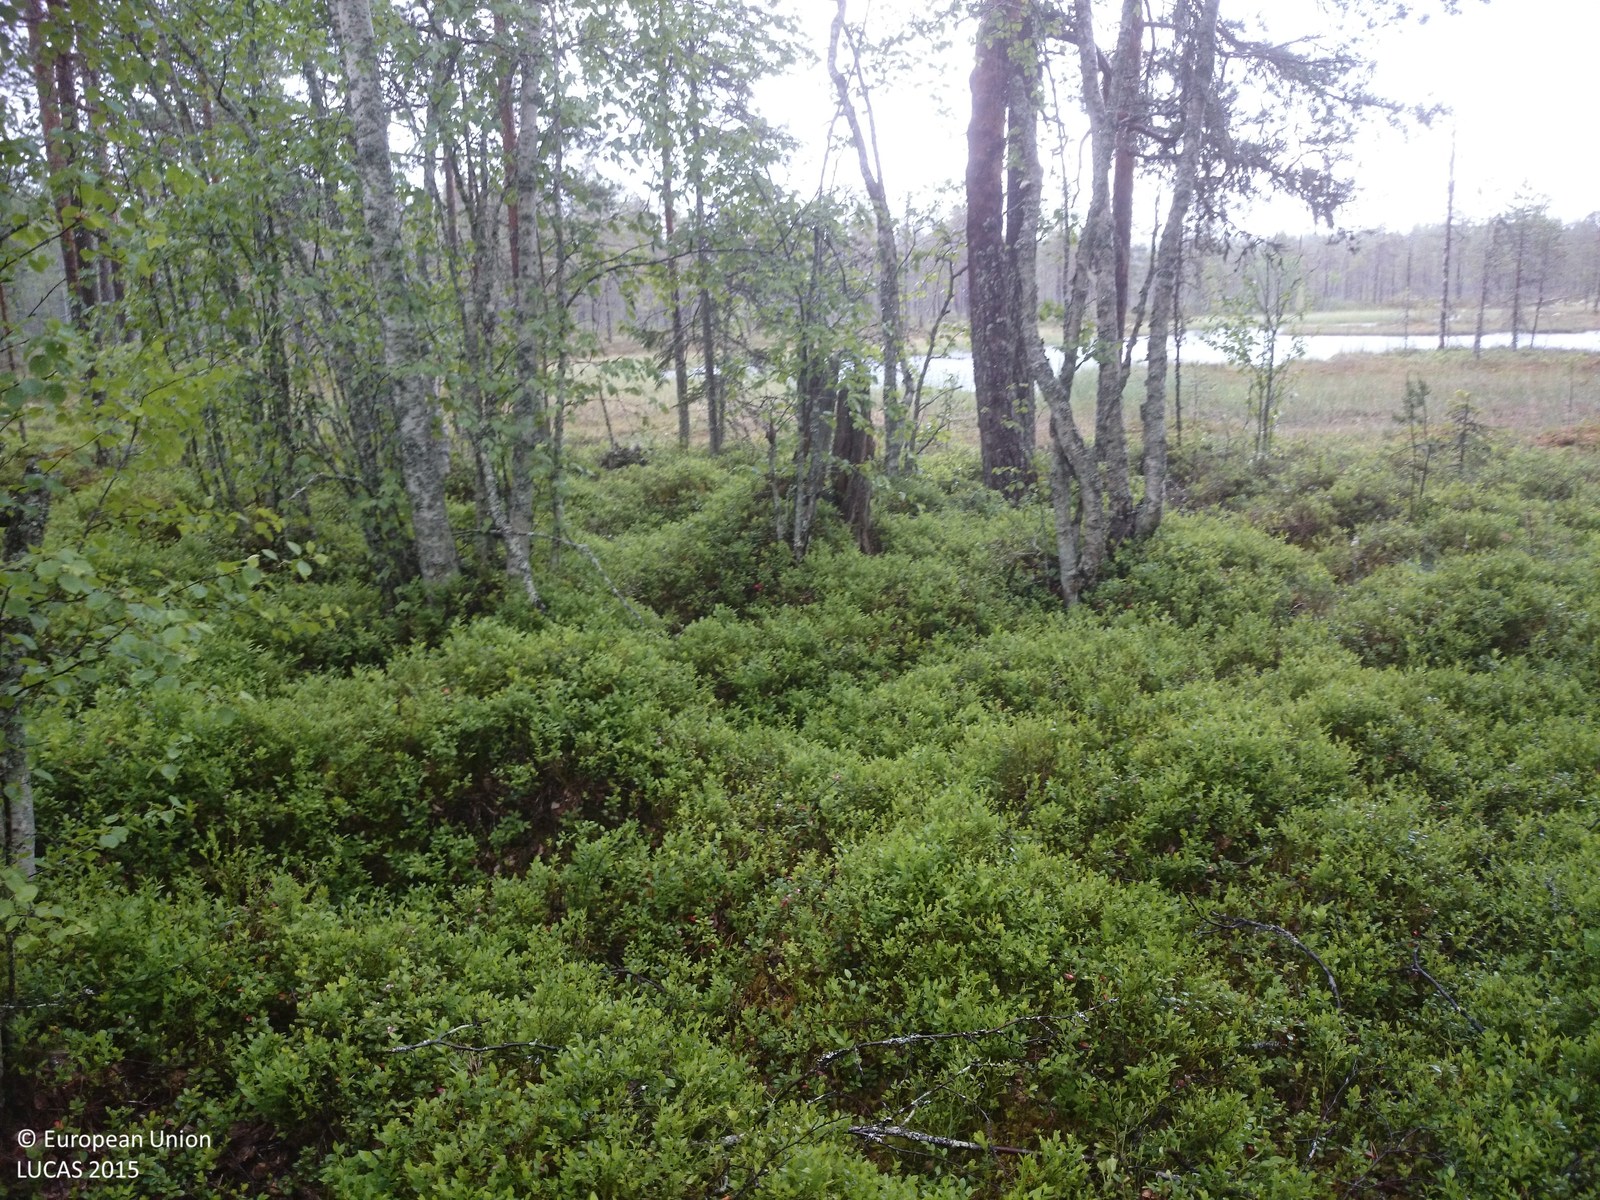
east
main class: Woodland
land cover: Broadleaved woodland
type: hemiboreal forest and nemoral coniferous forest and mixed broadleaved-coniferous forest
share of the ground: 25 - 50 %
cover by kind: shrubs 60 %, broadleaved forest trees 30 %, lichens and mosses 10 %
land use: Semi-natural and natural areas not in use
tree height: > 5 m
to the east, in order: Broadleaved woodland; Peatbogs; Pine dominated coniferous woodland; Spruce dominated coniferous woodland
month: June
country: SE
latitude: 62.1029
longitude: 16.2459
